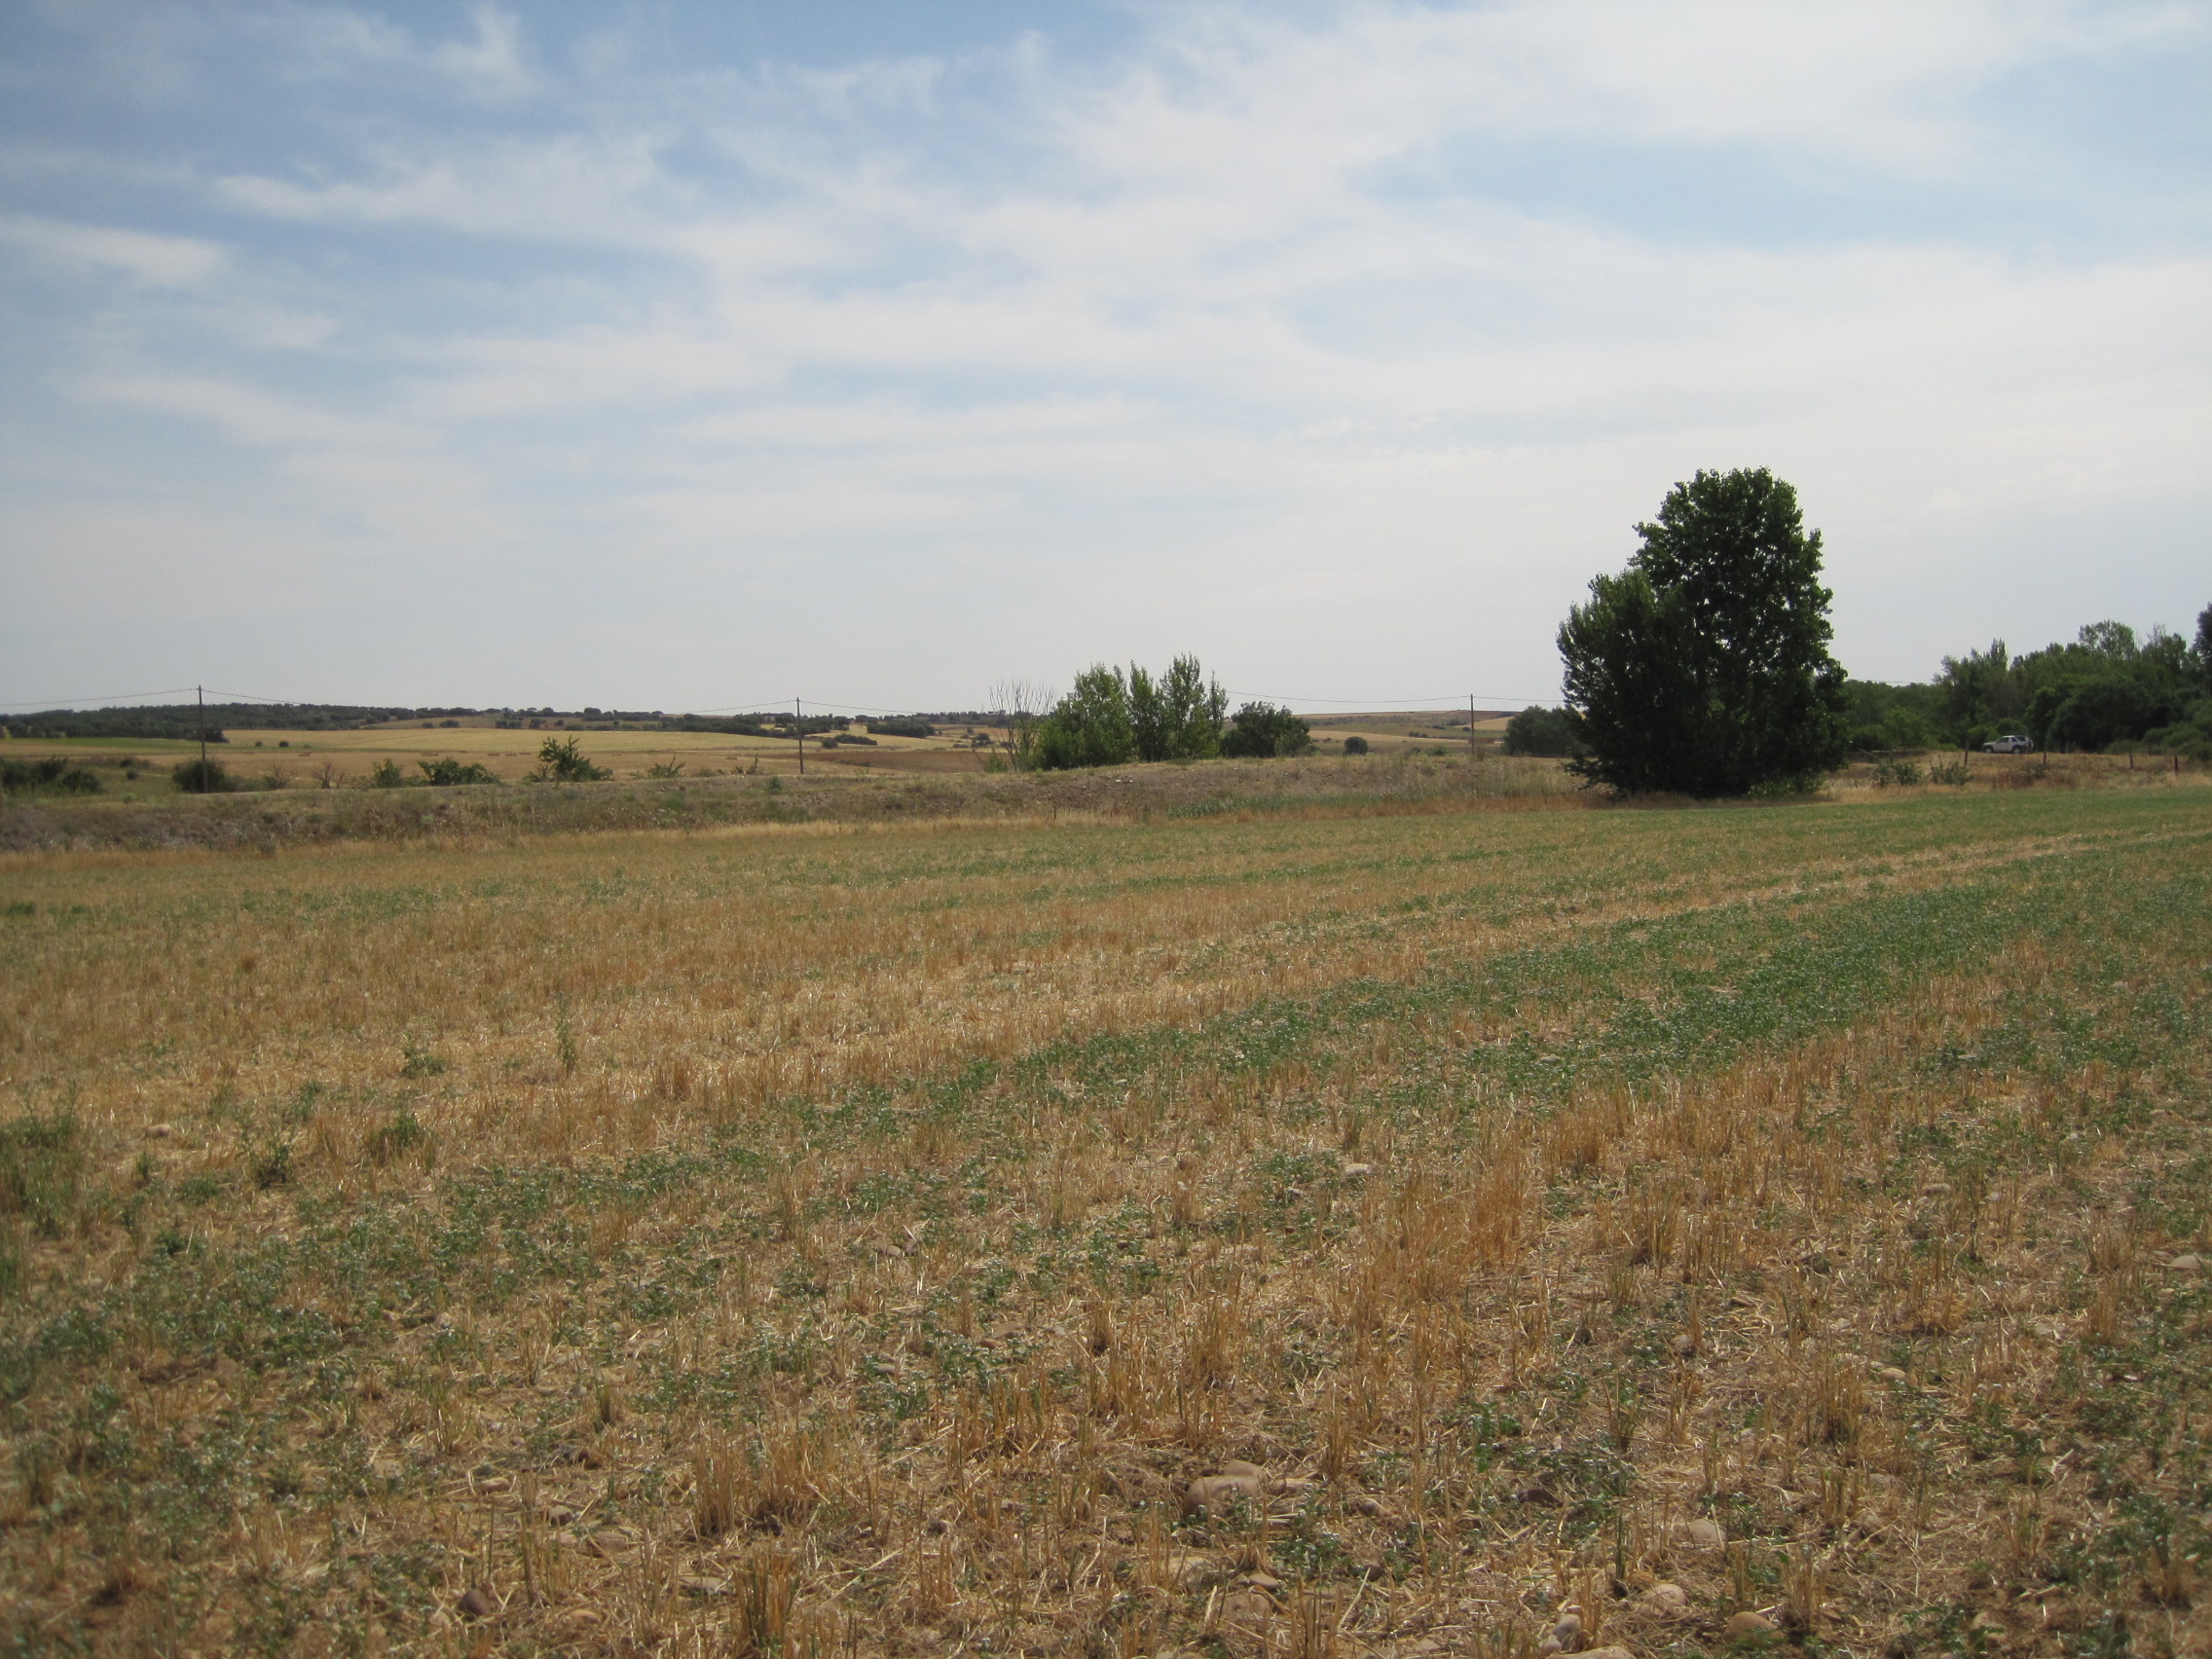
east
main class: Cropland
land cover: Common wheat
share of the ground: < 10 %
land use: Agriculture (excluding fallow land and kitchen gardens)
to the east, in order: Common wheat; Abandoned hedges; Inland fresh water bodies; Grassland without tree/shrub cover; Inland fresh running water; Grassland with sparse tree/shrub cover; Electric lines; Grassland without tree/shrub cover; Tracks; Grassland without tree/shrub cover; Tracks; Grass margins; Common wheat
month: July
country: ES
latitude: 41.7302
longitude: -5.4846
